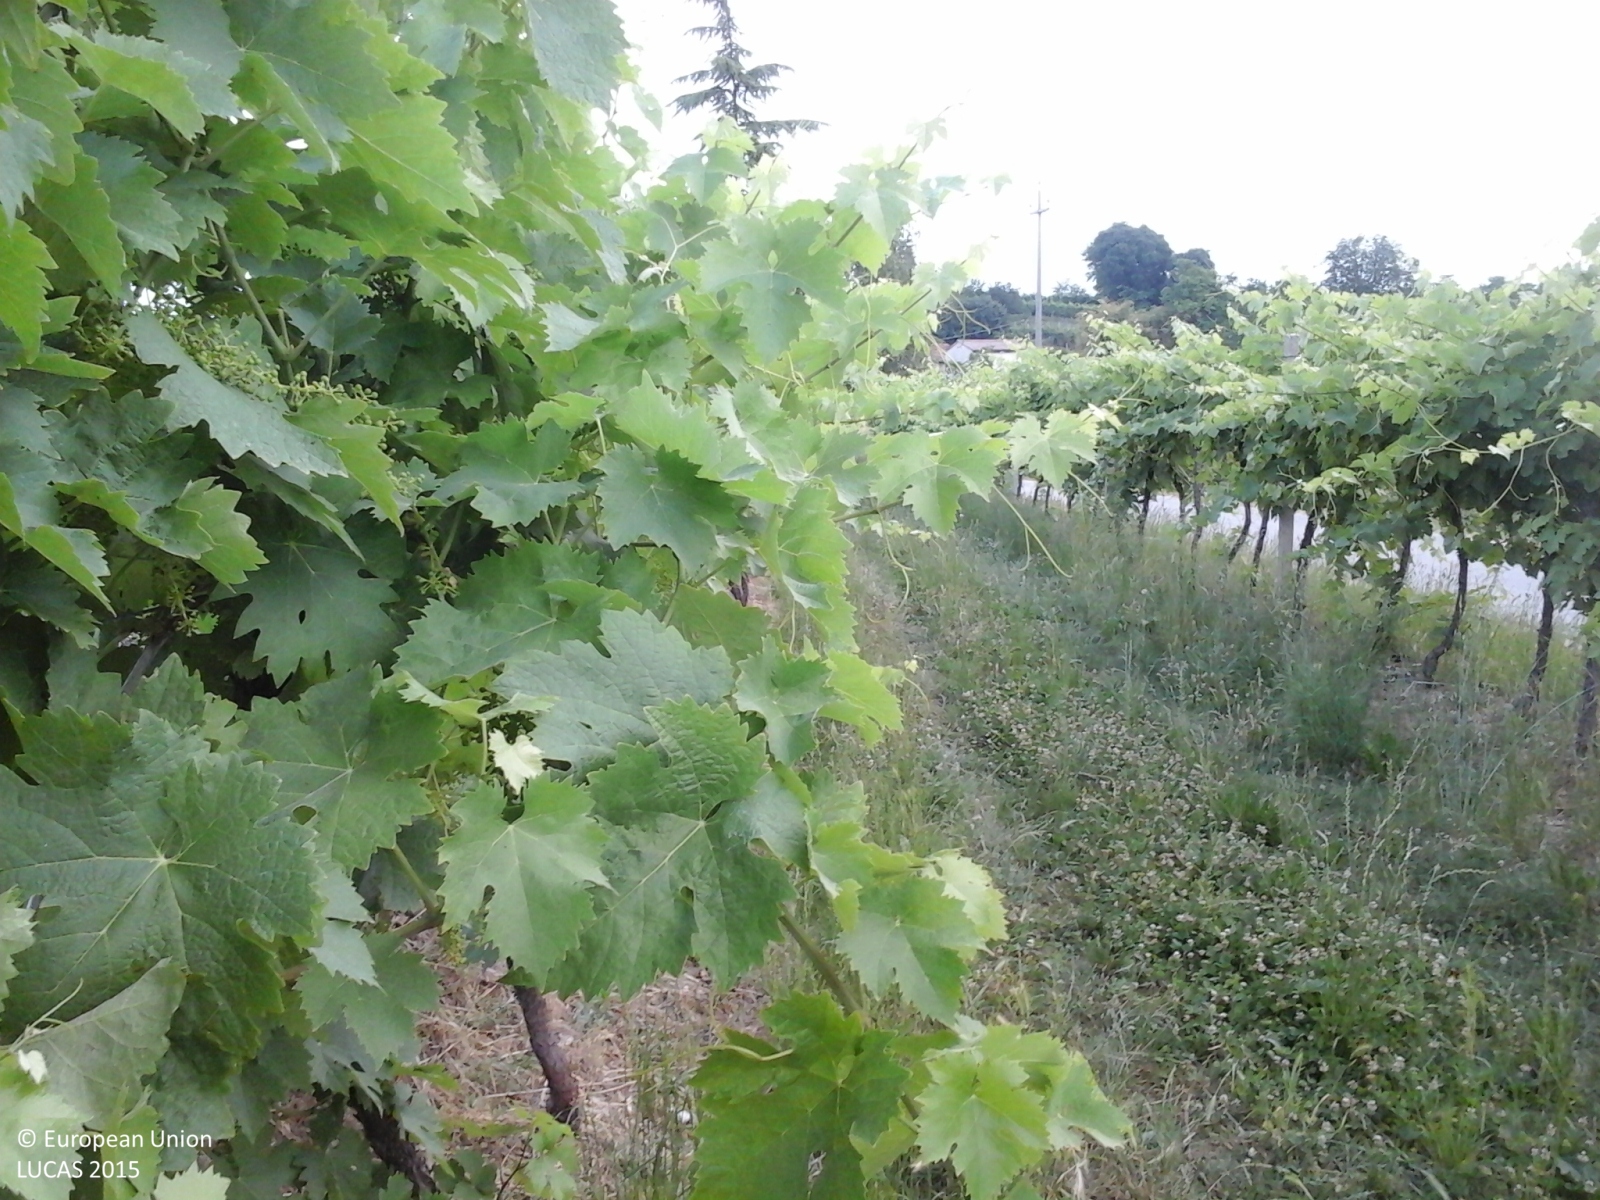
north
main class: Cropland
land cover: Vineyards
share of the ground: 25 - 50 %
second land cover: Grassland without tree/shrub cover
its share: > 75 %
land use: Agriculture (excluding fallow land and kitchen gardens)
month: June
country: IT
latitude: 45.4477
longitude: 10.7531
